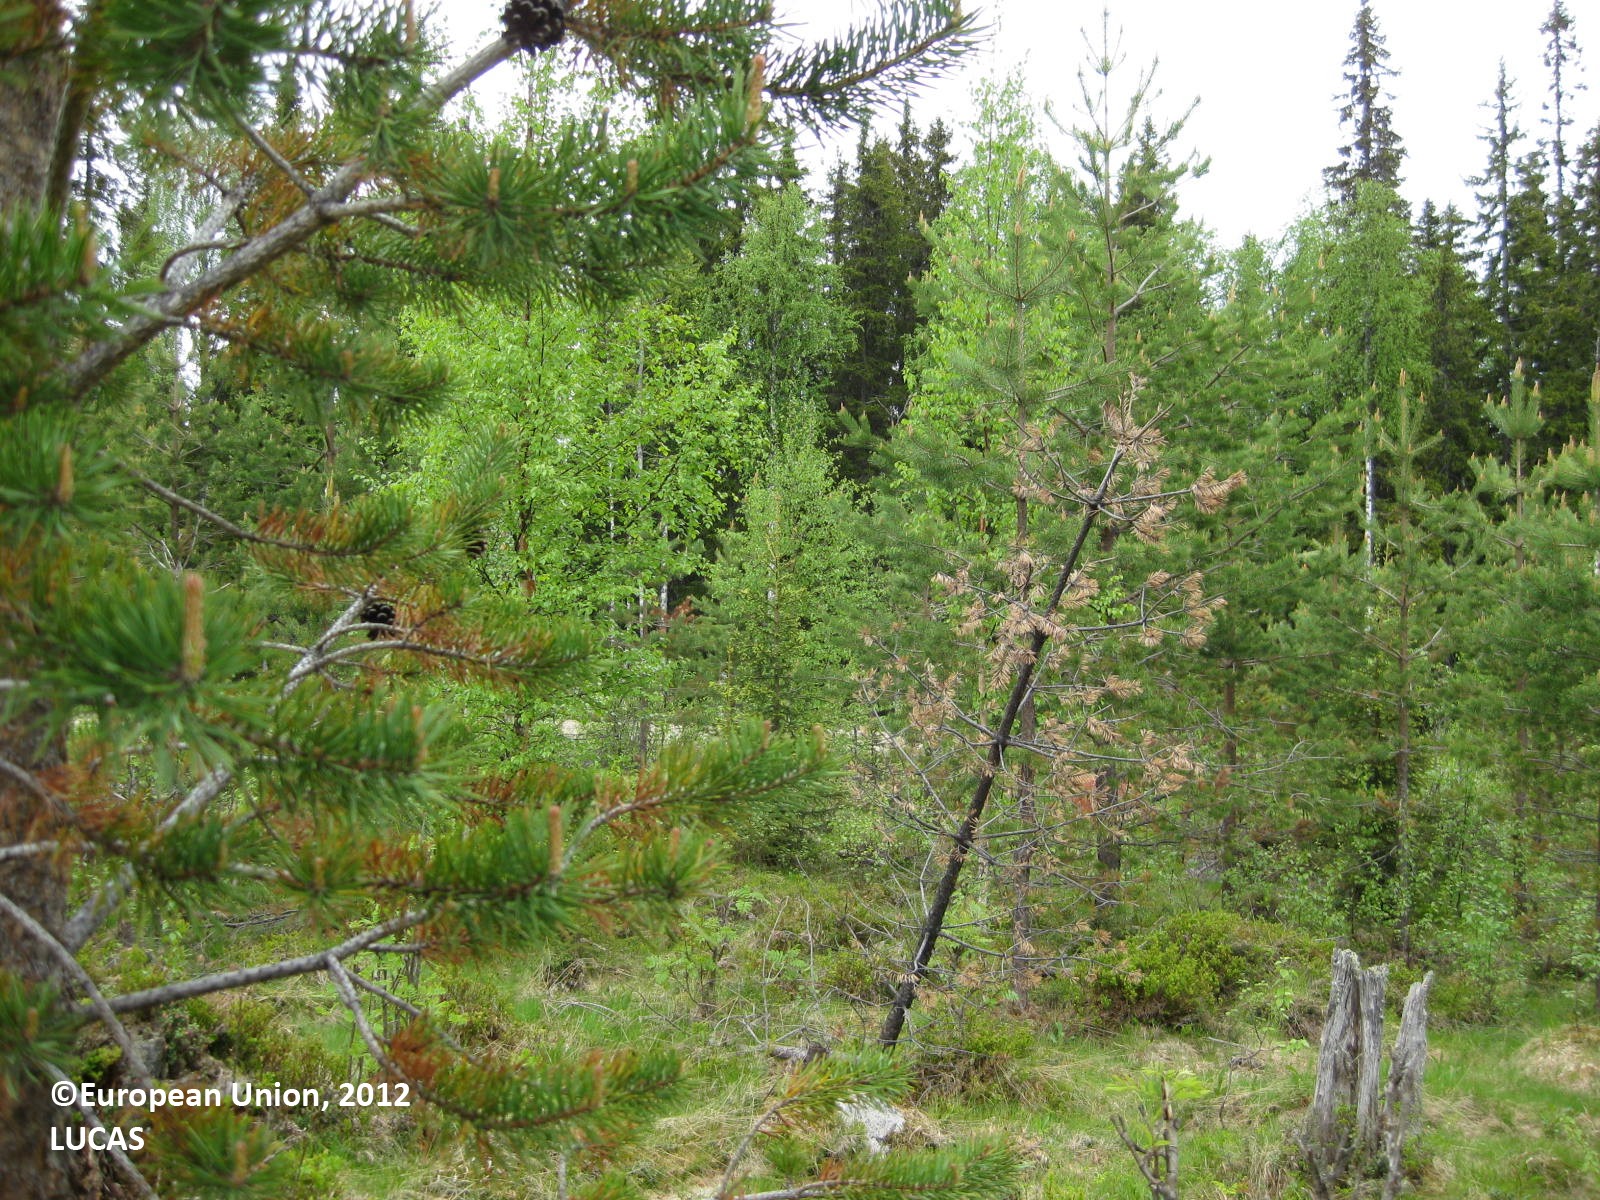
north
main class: Woodland
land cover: Pine dominated mixed woodland
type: boreal forest
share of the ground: 50 - 75 %
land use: Forestry
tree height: < 5 m
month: June
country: FI
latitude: 65.2240
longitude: 28.9366
